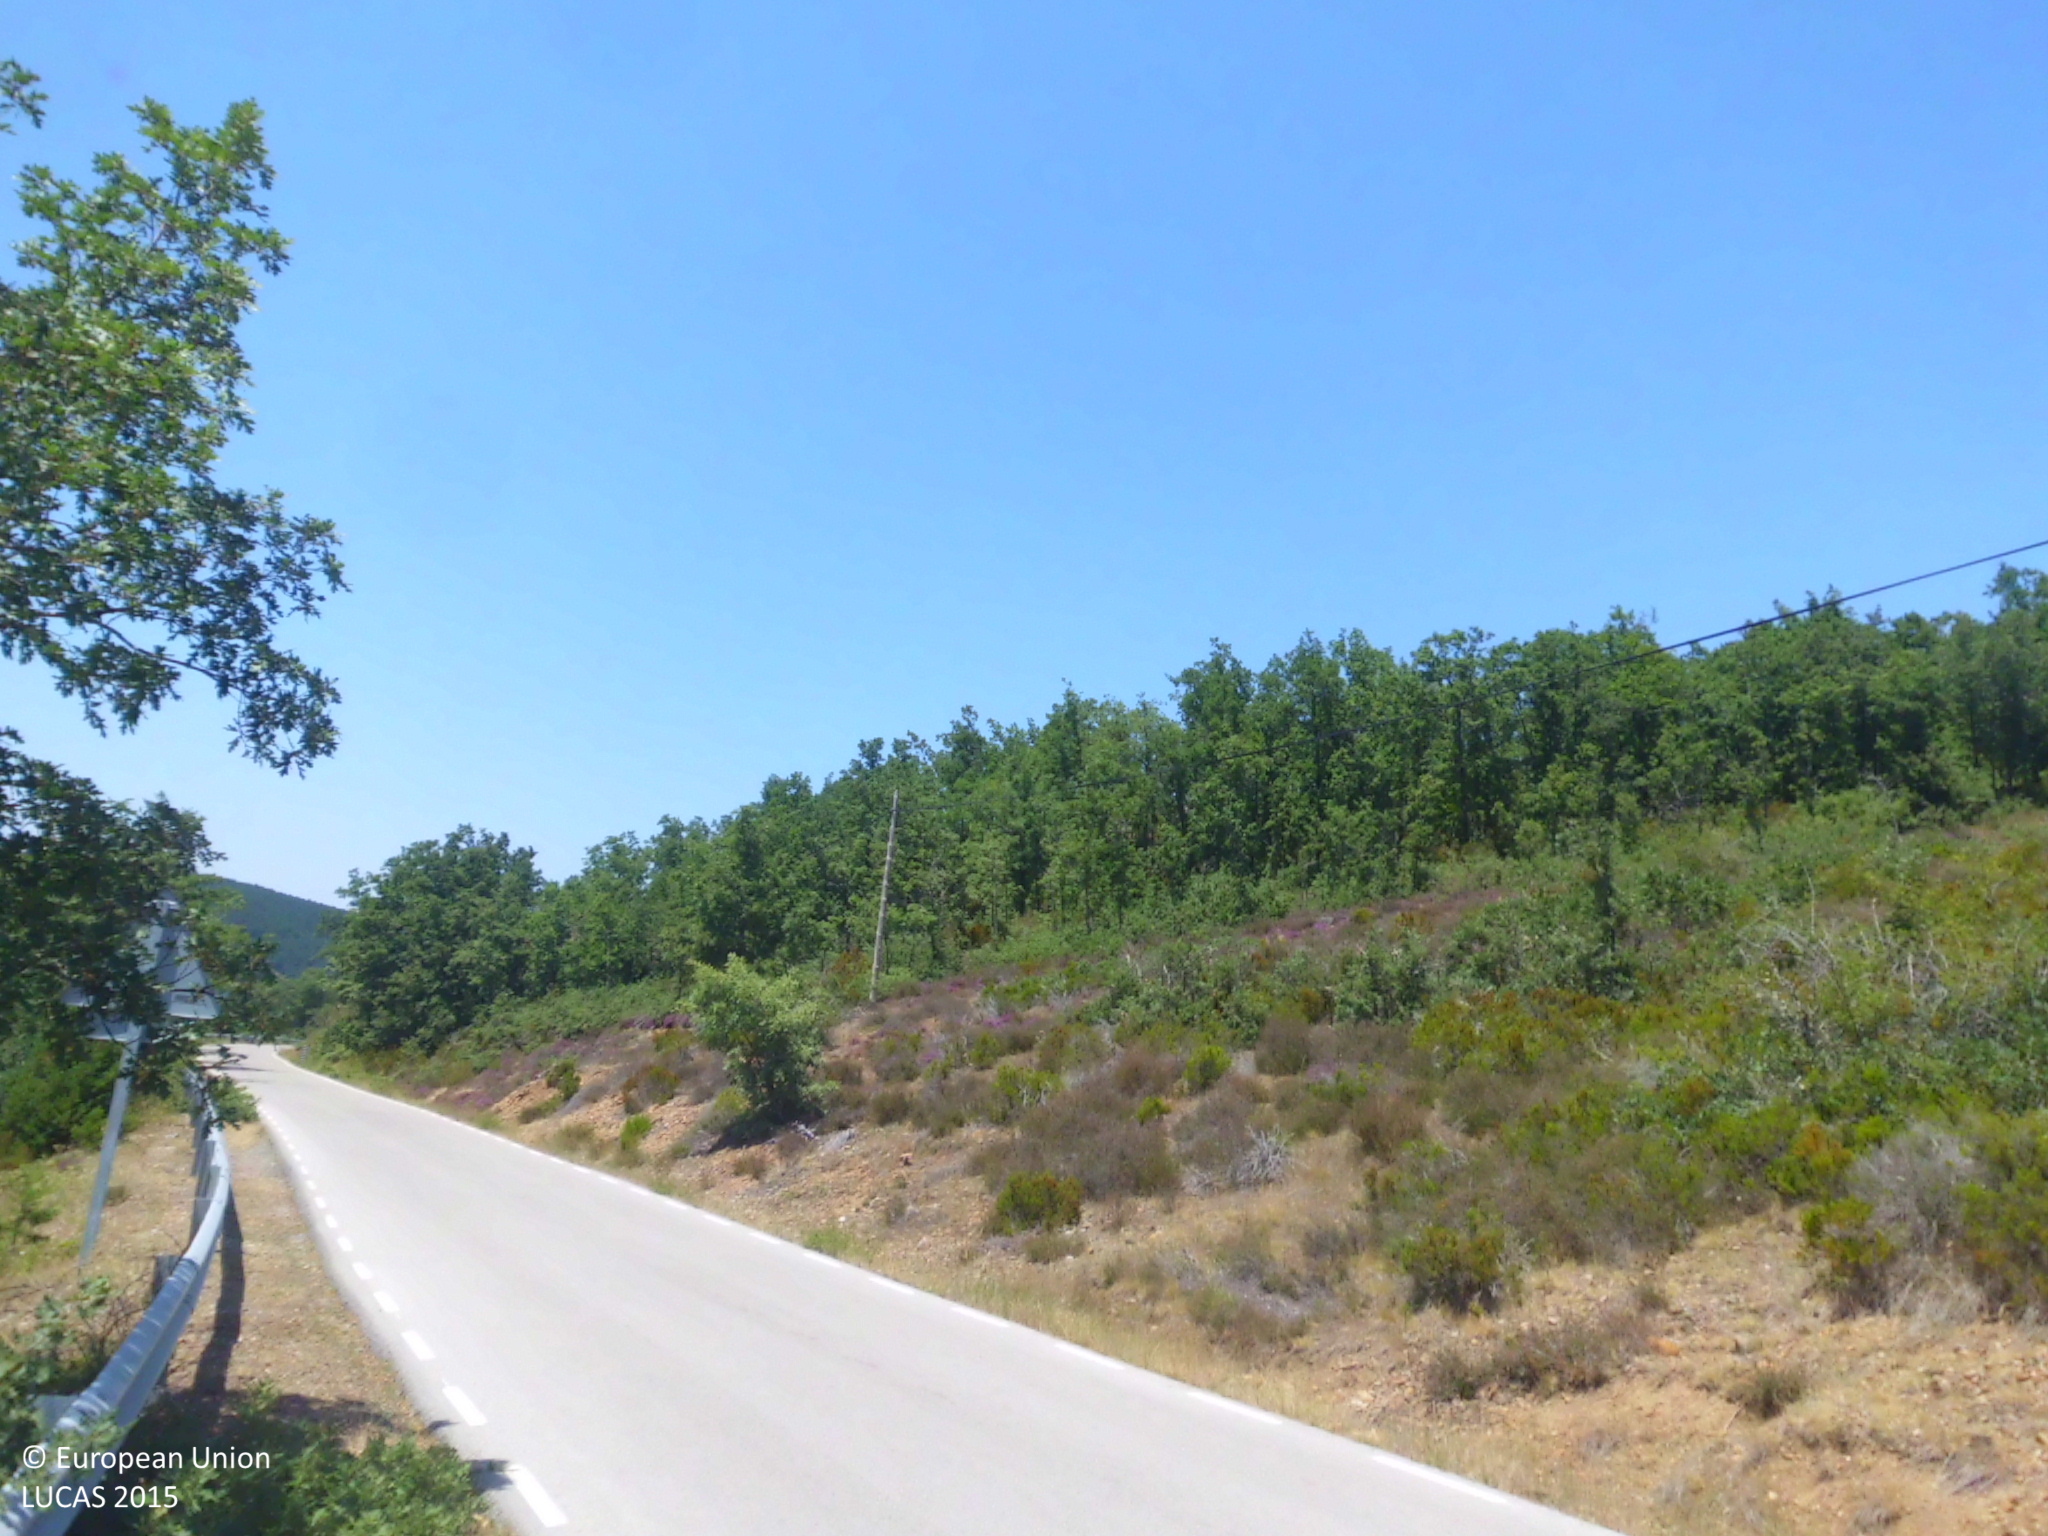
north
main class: Woodland
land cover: Pine dominated coniferous woodland
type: coniferous forest of the mediterranean region
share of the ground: > 75 %
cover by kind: coniferous forest trees 100 %
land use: Forestry
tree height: > 5 m
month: July
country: ES
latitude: 42.2413
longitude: -3.3485
